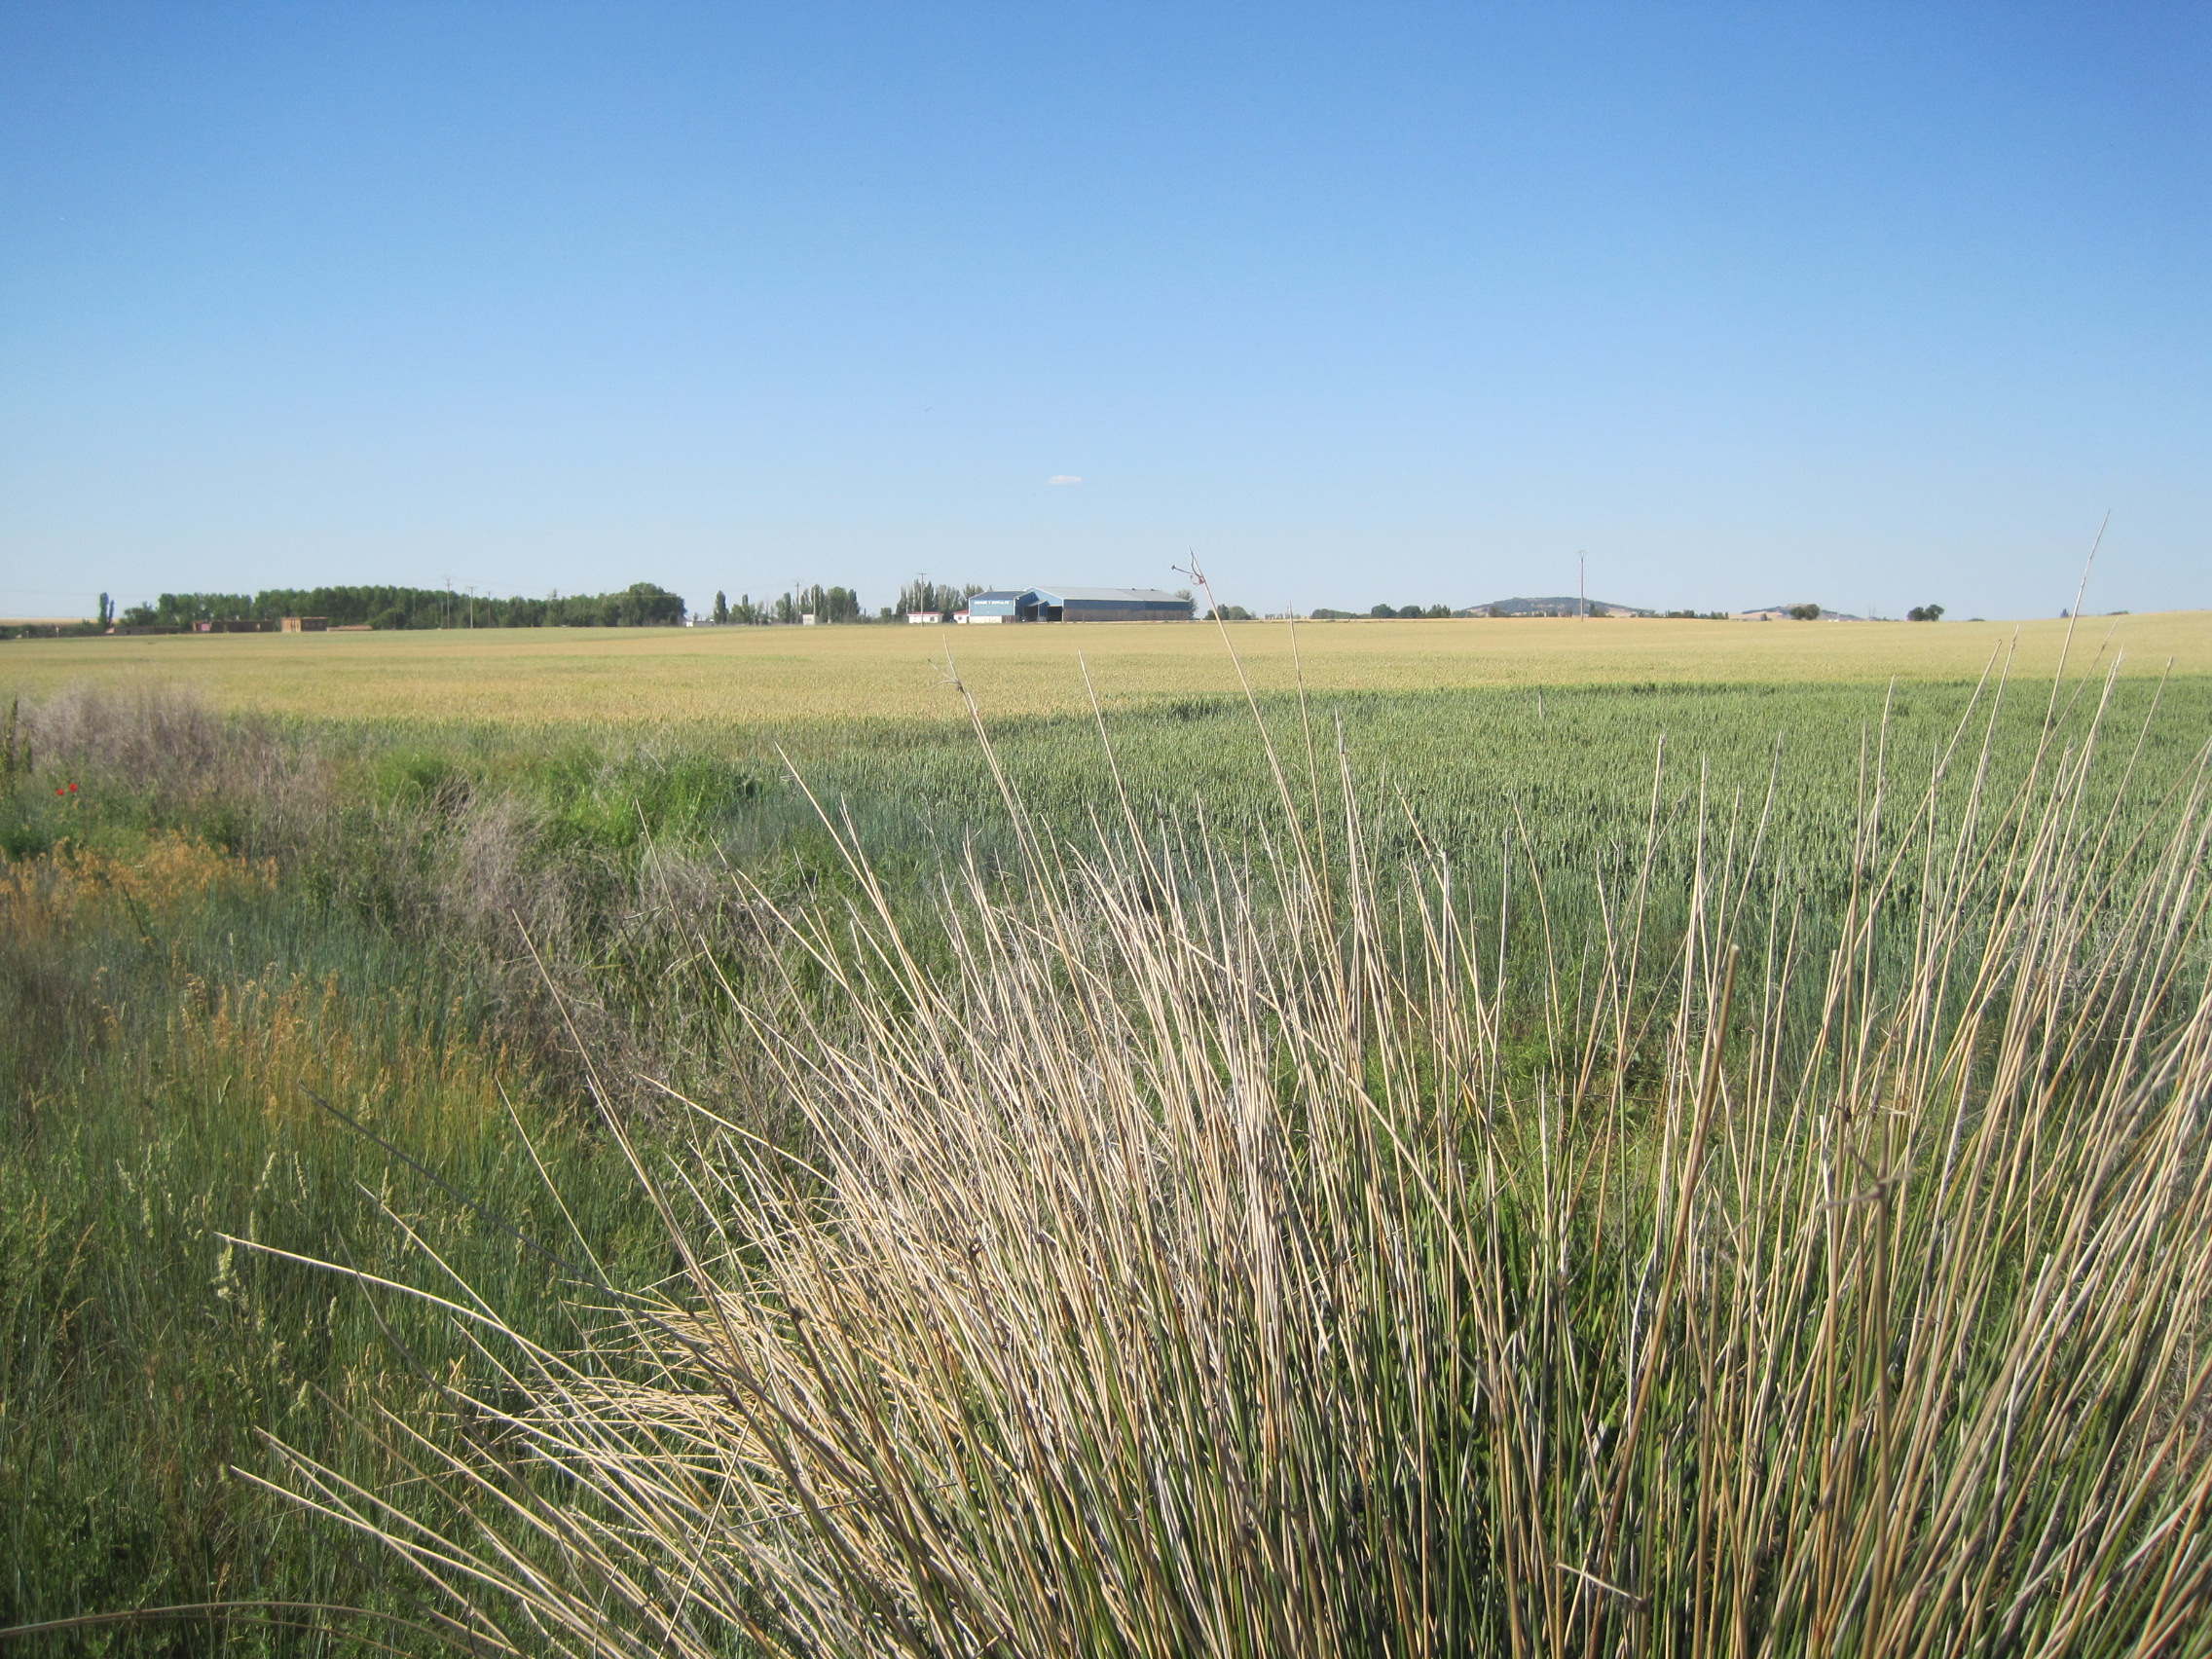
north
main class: Cropland
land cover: Common wheat
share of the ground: > 75 %
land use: Agriculture (excluding fallow land and kitchen gardens)
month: June
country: ES
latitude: 41.7528
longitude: -5.2206
